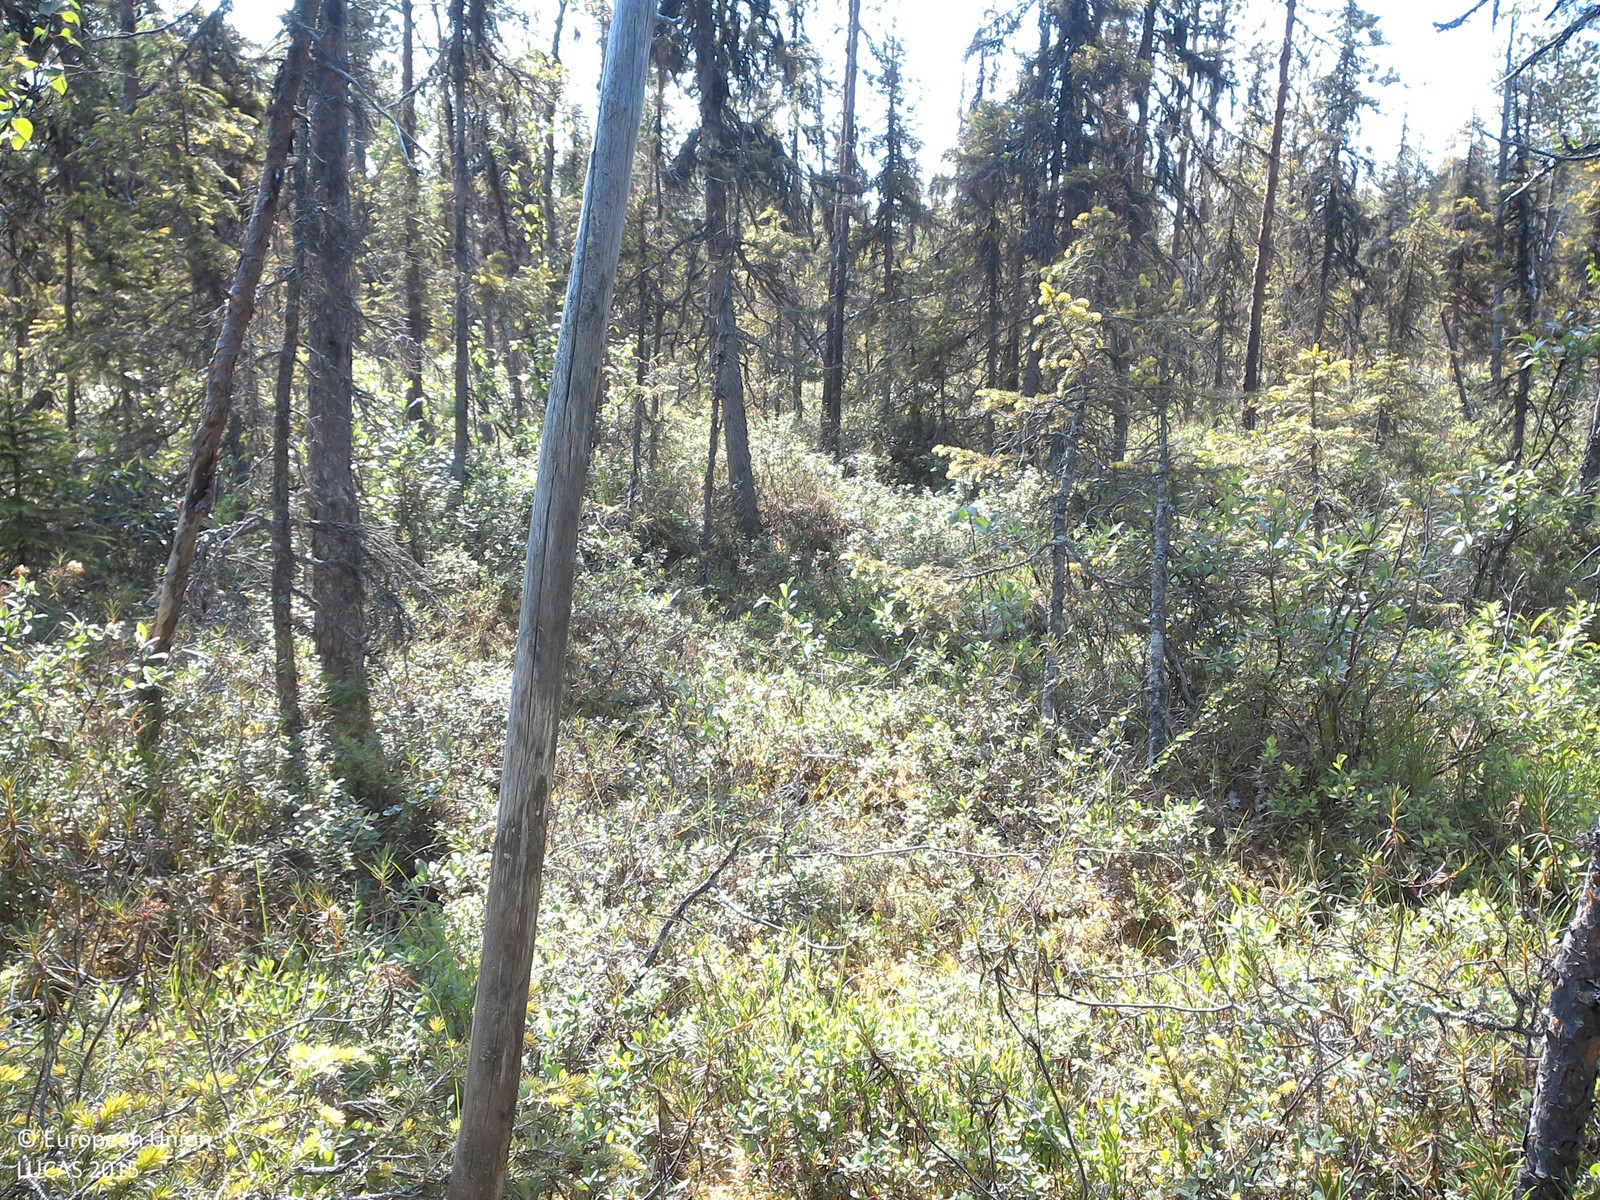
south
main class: Woodland
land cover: Spruce dominated coniferous woodland
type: boreal forest
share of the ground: 25 - 50 %
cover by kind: shrubs 50 %, coniferous forest trees 30 %, lichens and mosses 15 %, broadleaved forest trees 5 %
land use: Semi-natural and natural areas not in use
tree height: > 5 m
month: July
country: SE
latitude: 66.9775
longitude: 22.8695
